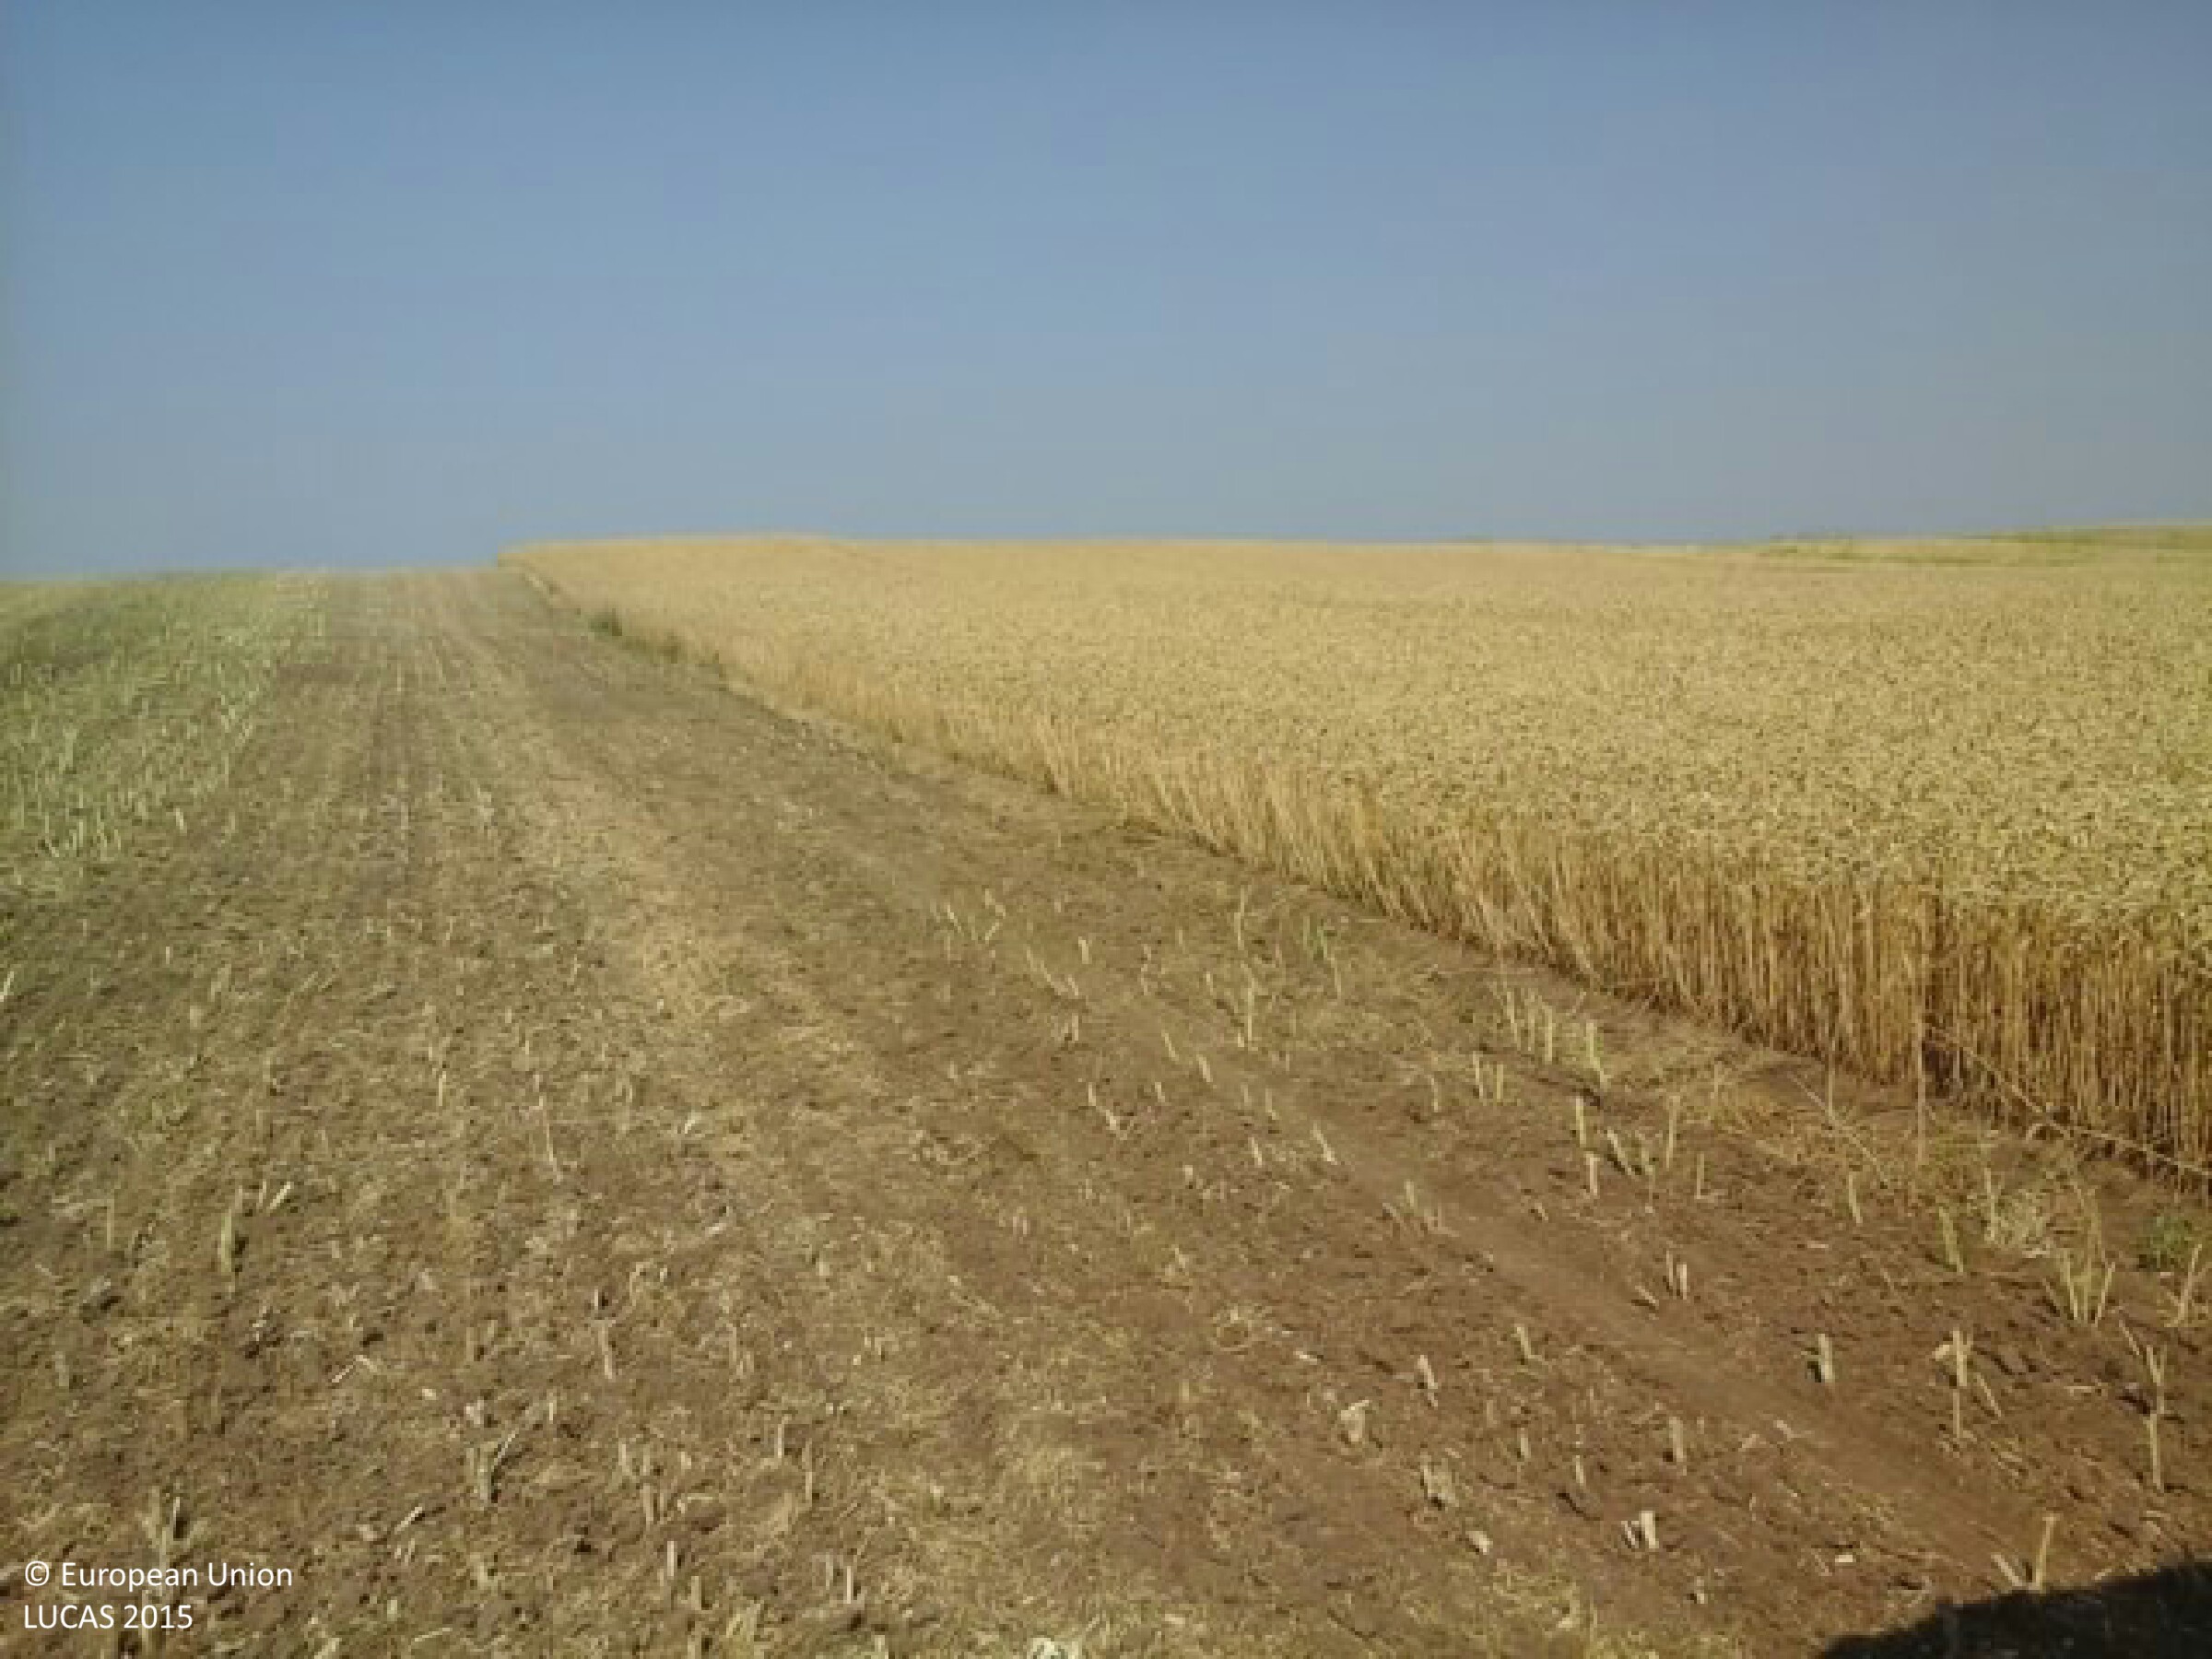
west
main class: Cropland
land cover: Rape and turnip rape
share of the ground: < 10 %
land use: Agriculture (excluding fallow land and kitchen gardens)
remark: Harvested field
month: July
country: HU
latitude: 46.1561
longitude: 19.1683
